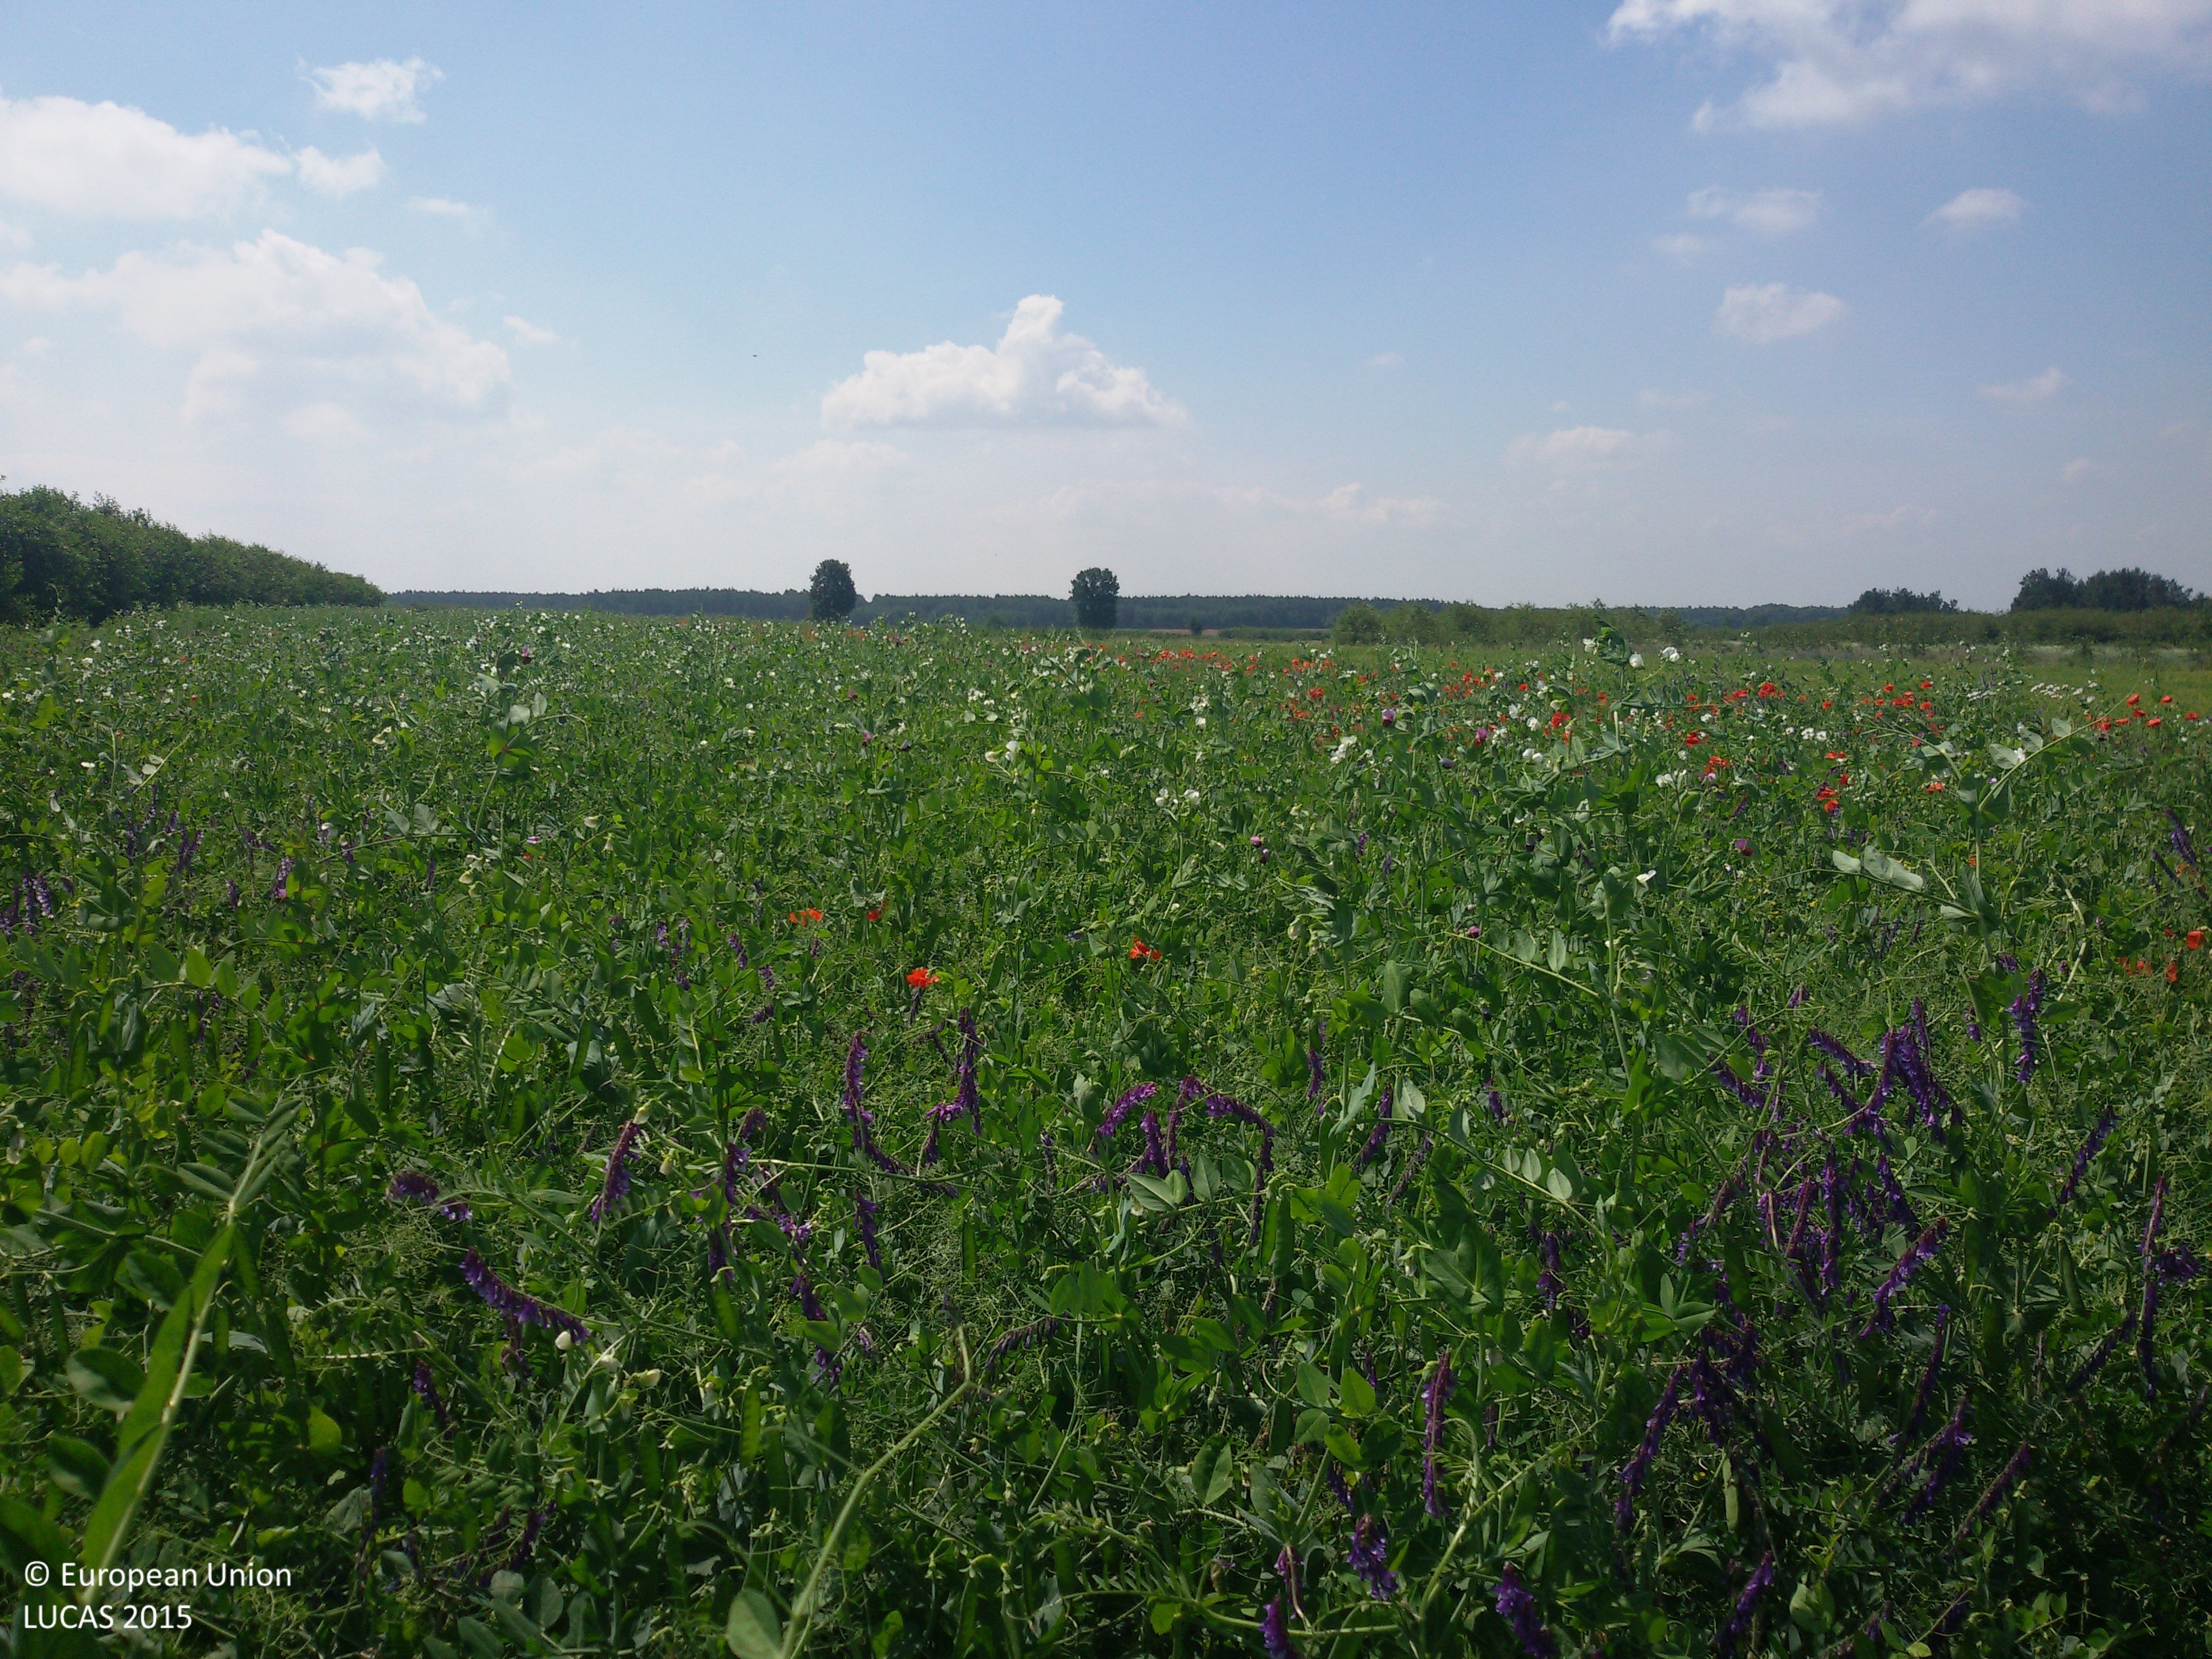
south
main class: Cropland
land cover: Other leguminous and mixtures for fodder
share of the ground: > 75 %
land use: Agriculture (excluding fallow land and kitchen gardens)
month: June
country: PL
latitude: 50.9563
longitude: 21.7425
